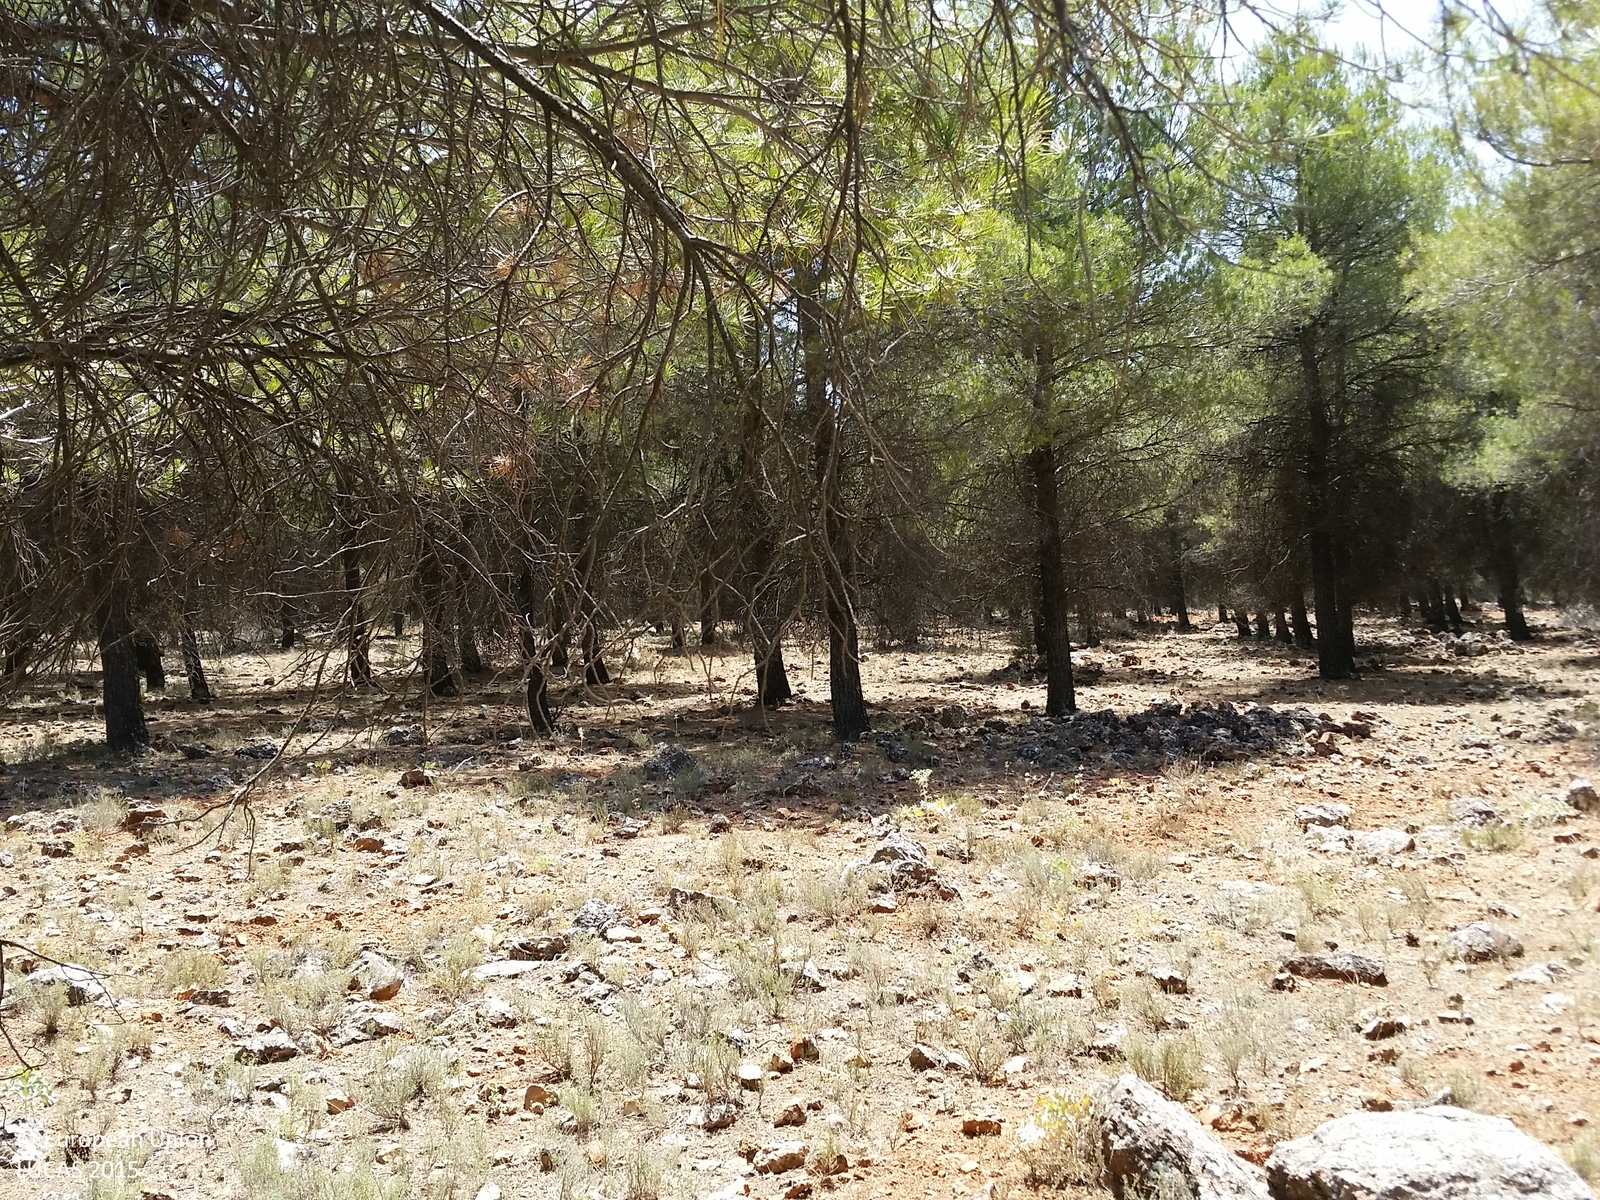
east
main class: Woodland
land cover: Pine dominated coniferous woodland
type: coniferous forest of the mediterranean region
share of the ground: > 75 %
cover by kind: coniferous forest trees 70 %, shrubs 20 %, consolidated bare surface 10 %
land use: Semi-natural and natural areas not in use
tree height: > 5 m
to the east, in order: Pine dominated coniferous woodland; Tracks; Pine dominated coniferous woodland
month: July
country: ES
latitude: 38.9193
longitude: -2.6118
